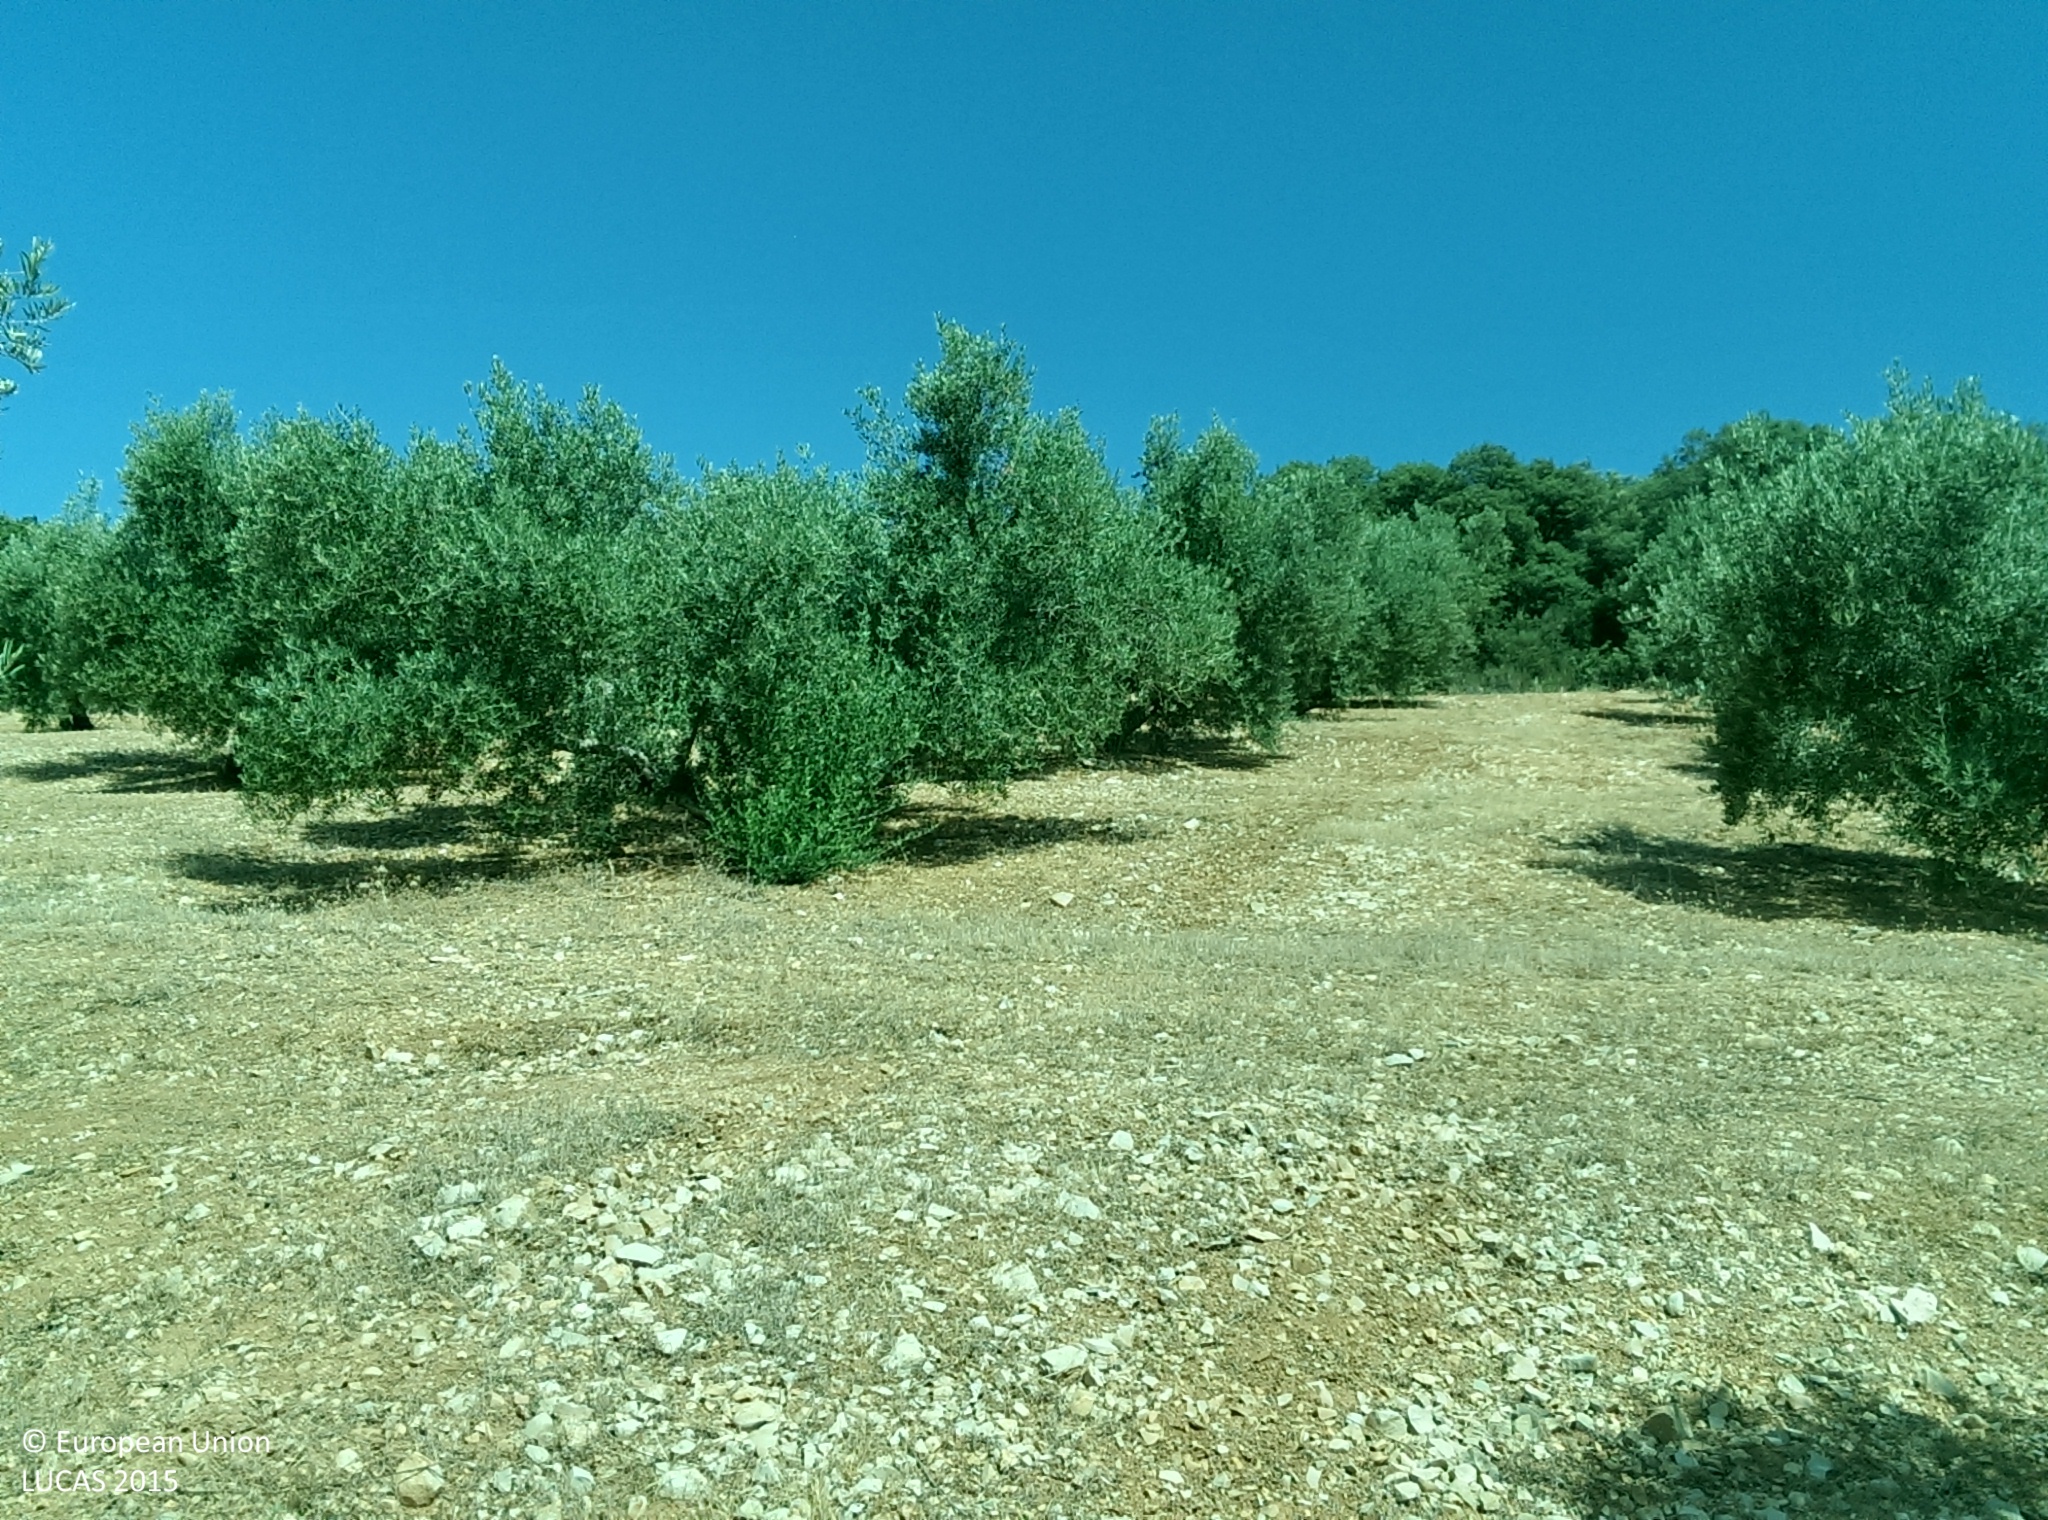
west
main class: Cropland
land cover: Olive groves
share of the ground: 25 - 50 %
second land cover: Spontaneously vegetated surfaces
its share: 25 - 50 %
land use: Agriculture (excluding fallow land and kitchen gardens)
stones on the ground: 10 - 25 %
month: July
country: ES
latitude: 37.4592
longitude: -3.7539
